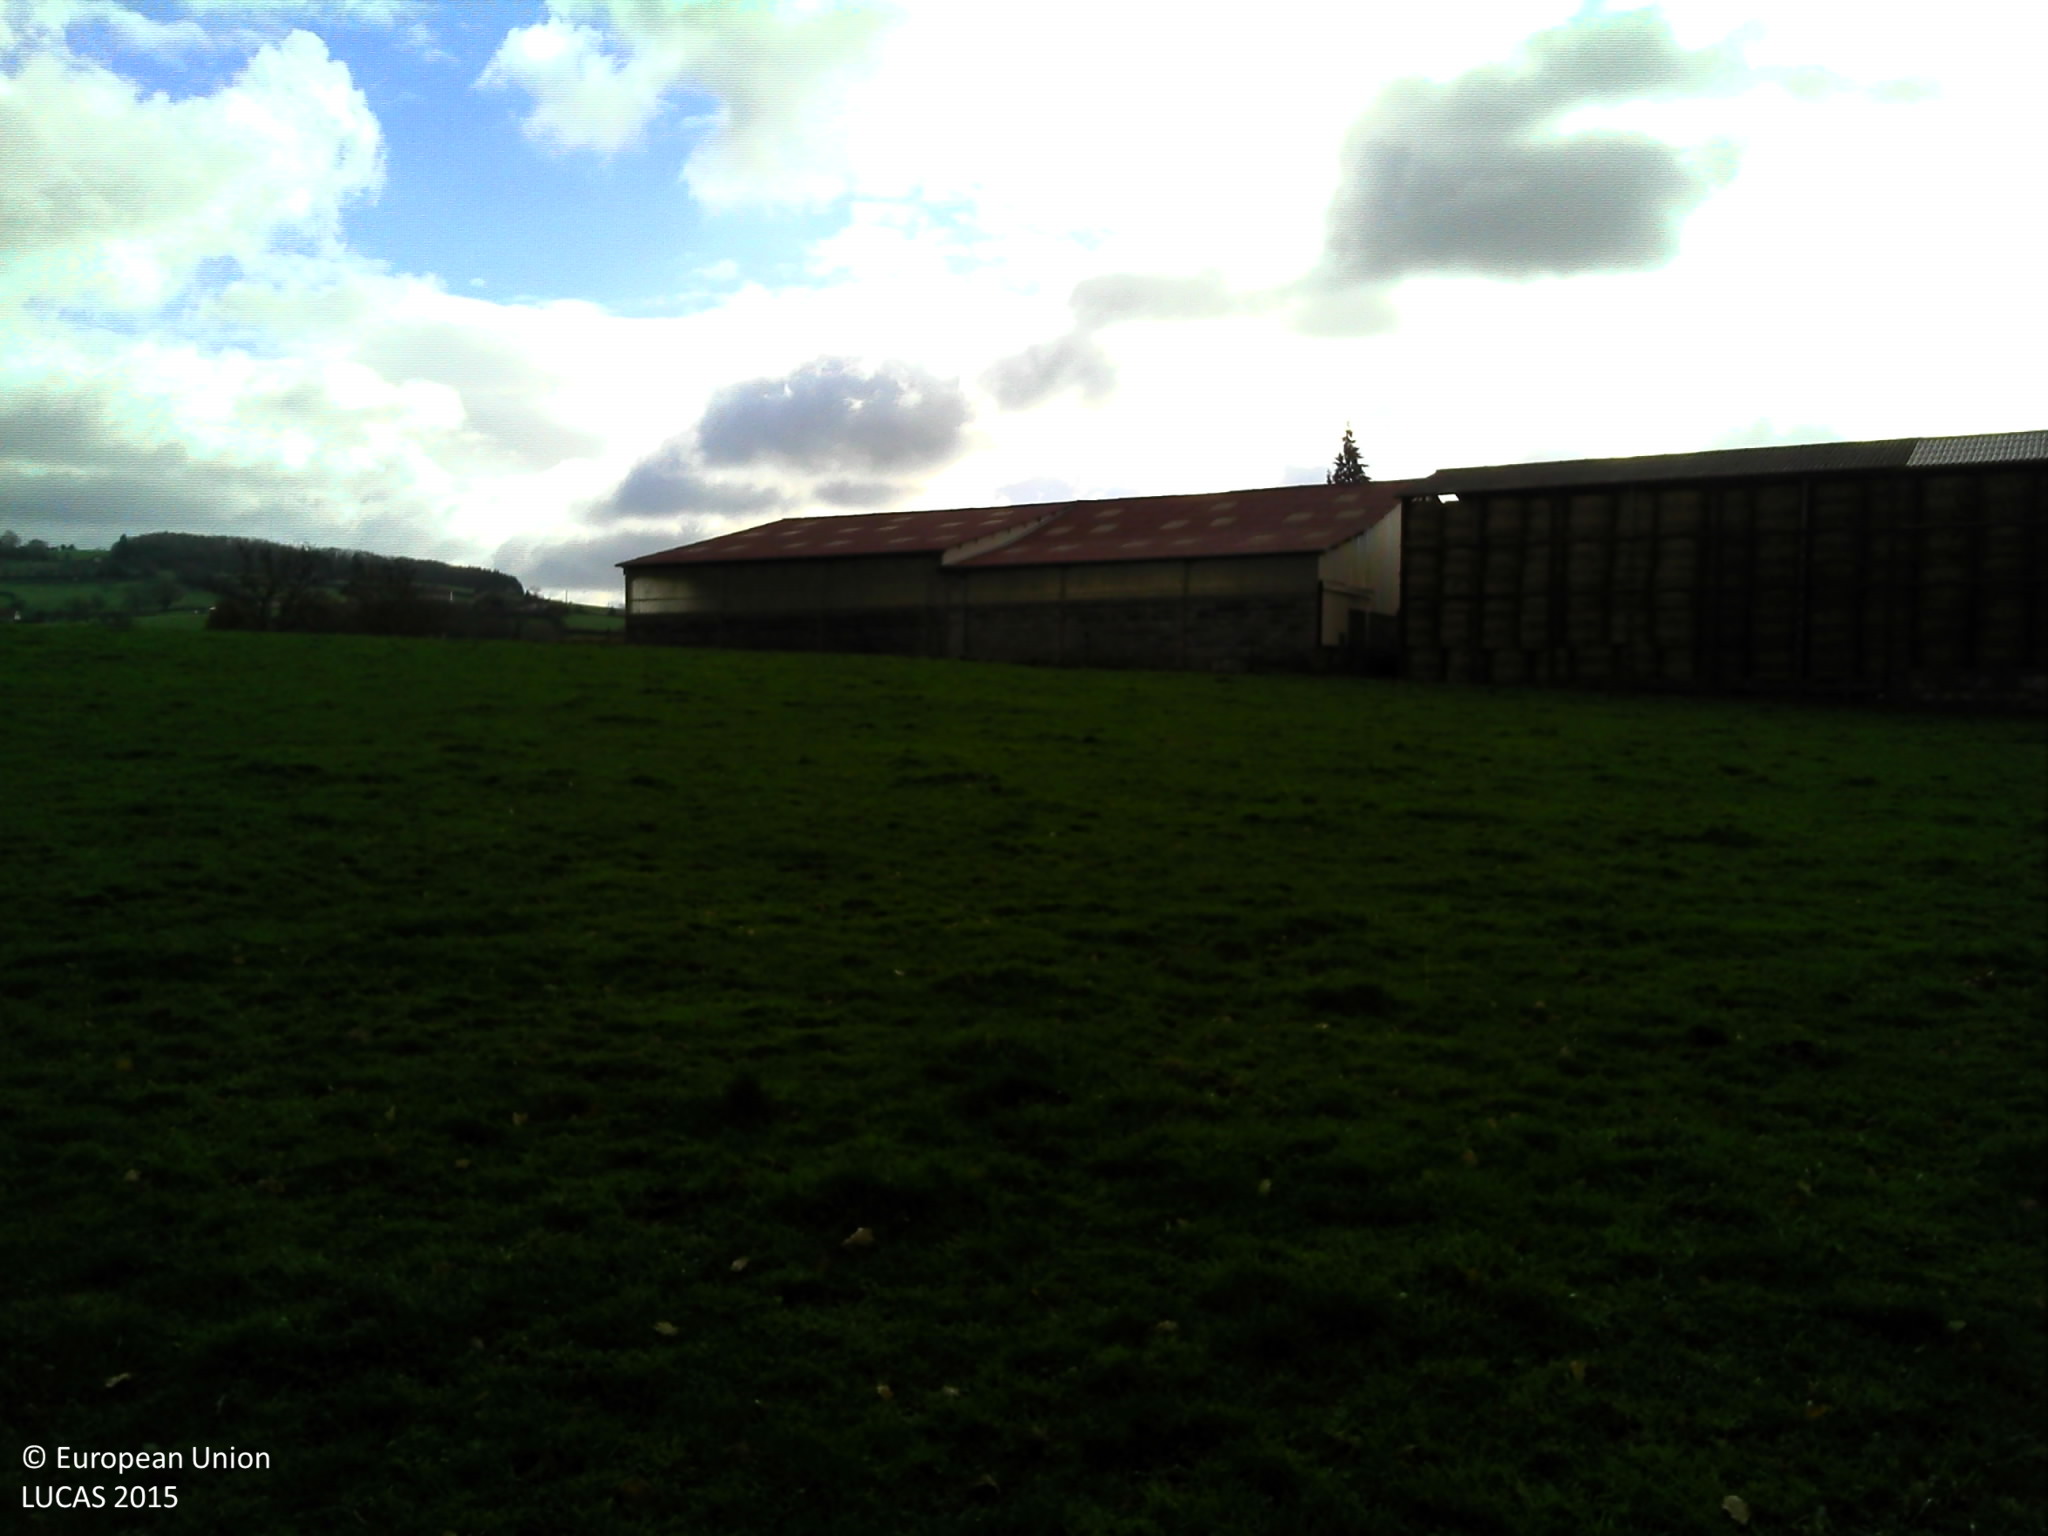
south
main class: Grassland
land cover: Grassland without tree/shrub cover
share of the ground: > 75 %
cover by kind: herbaceous plants 100 %
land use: Agriculture (excluding fallow land and kitchen gardens)
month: November
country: FR
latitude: 46.4177
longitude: 3.6895
